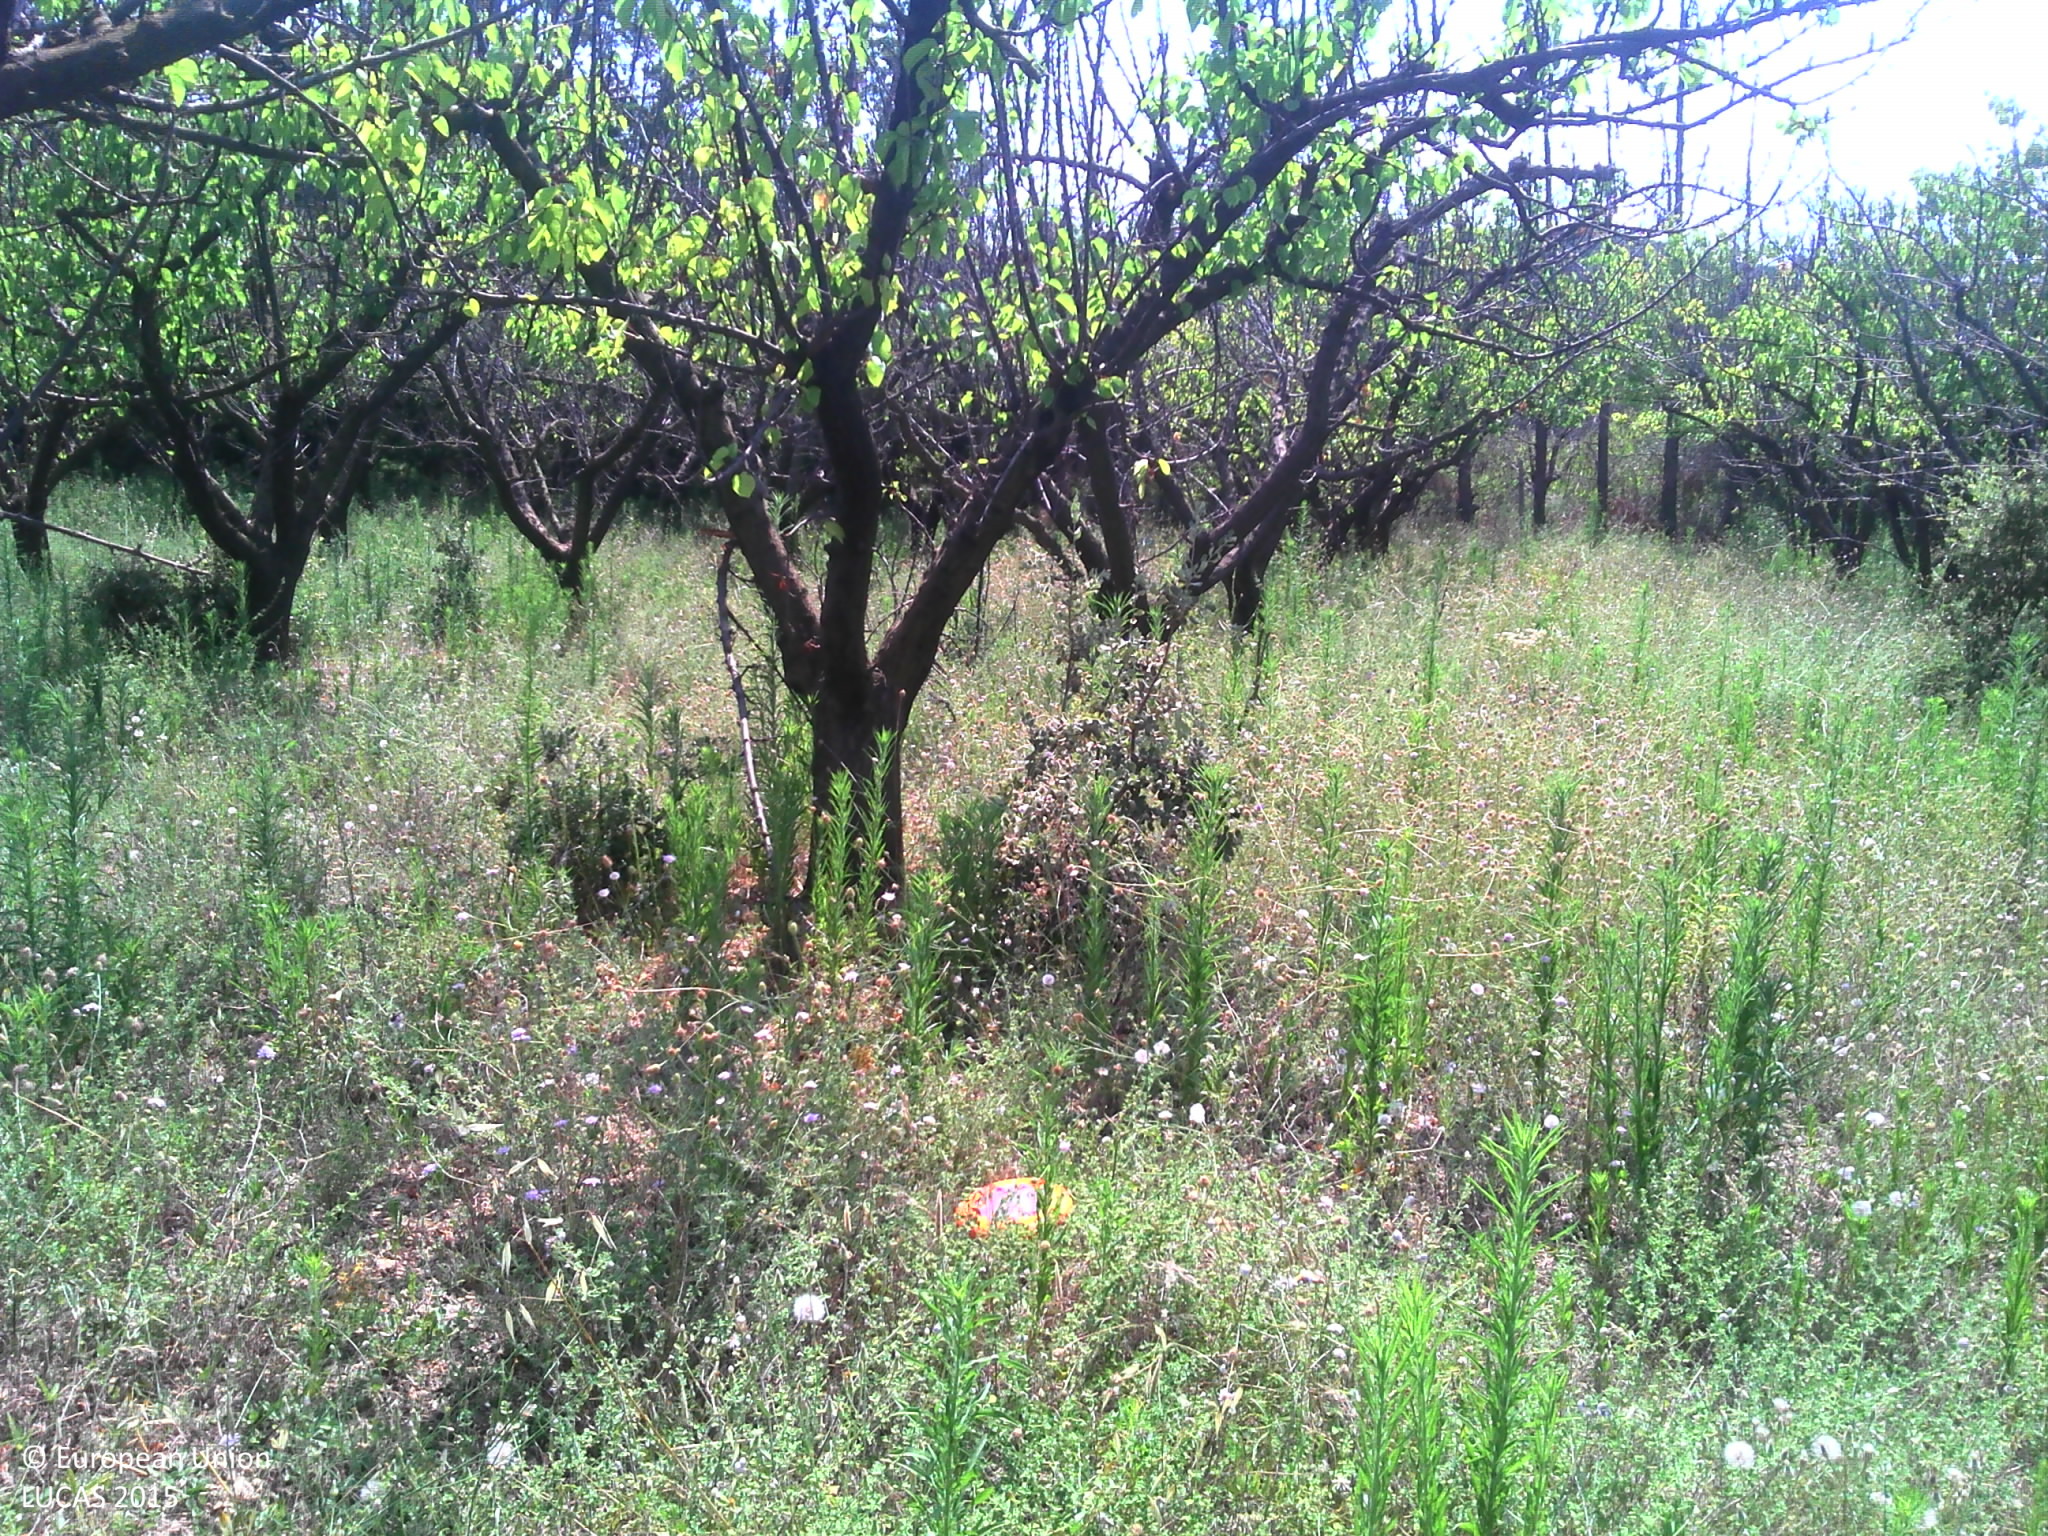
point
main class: Cropland
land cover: Other fruit trees and berries
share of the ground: 50 - 75 %
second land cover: Spontaneously vegetated surfaces
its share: 50 - 75 %
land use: Agriculture (excluding fallow land and kitchen gardens)
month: July
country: FR
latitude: 43.6751
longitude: 5.1101
